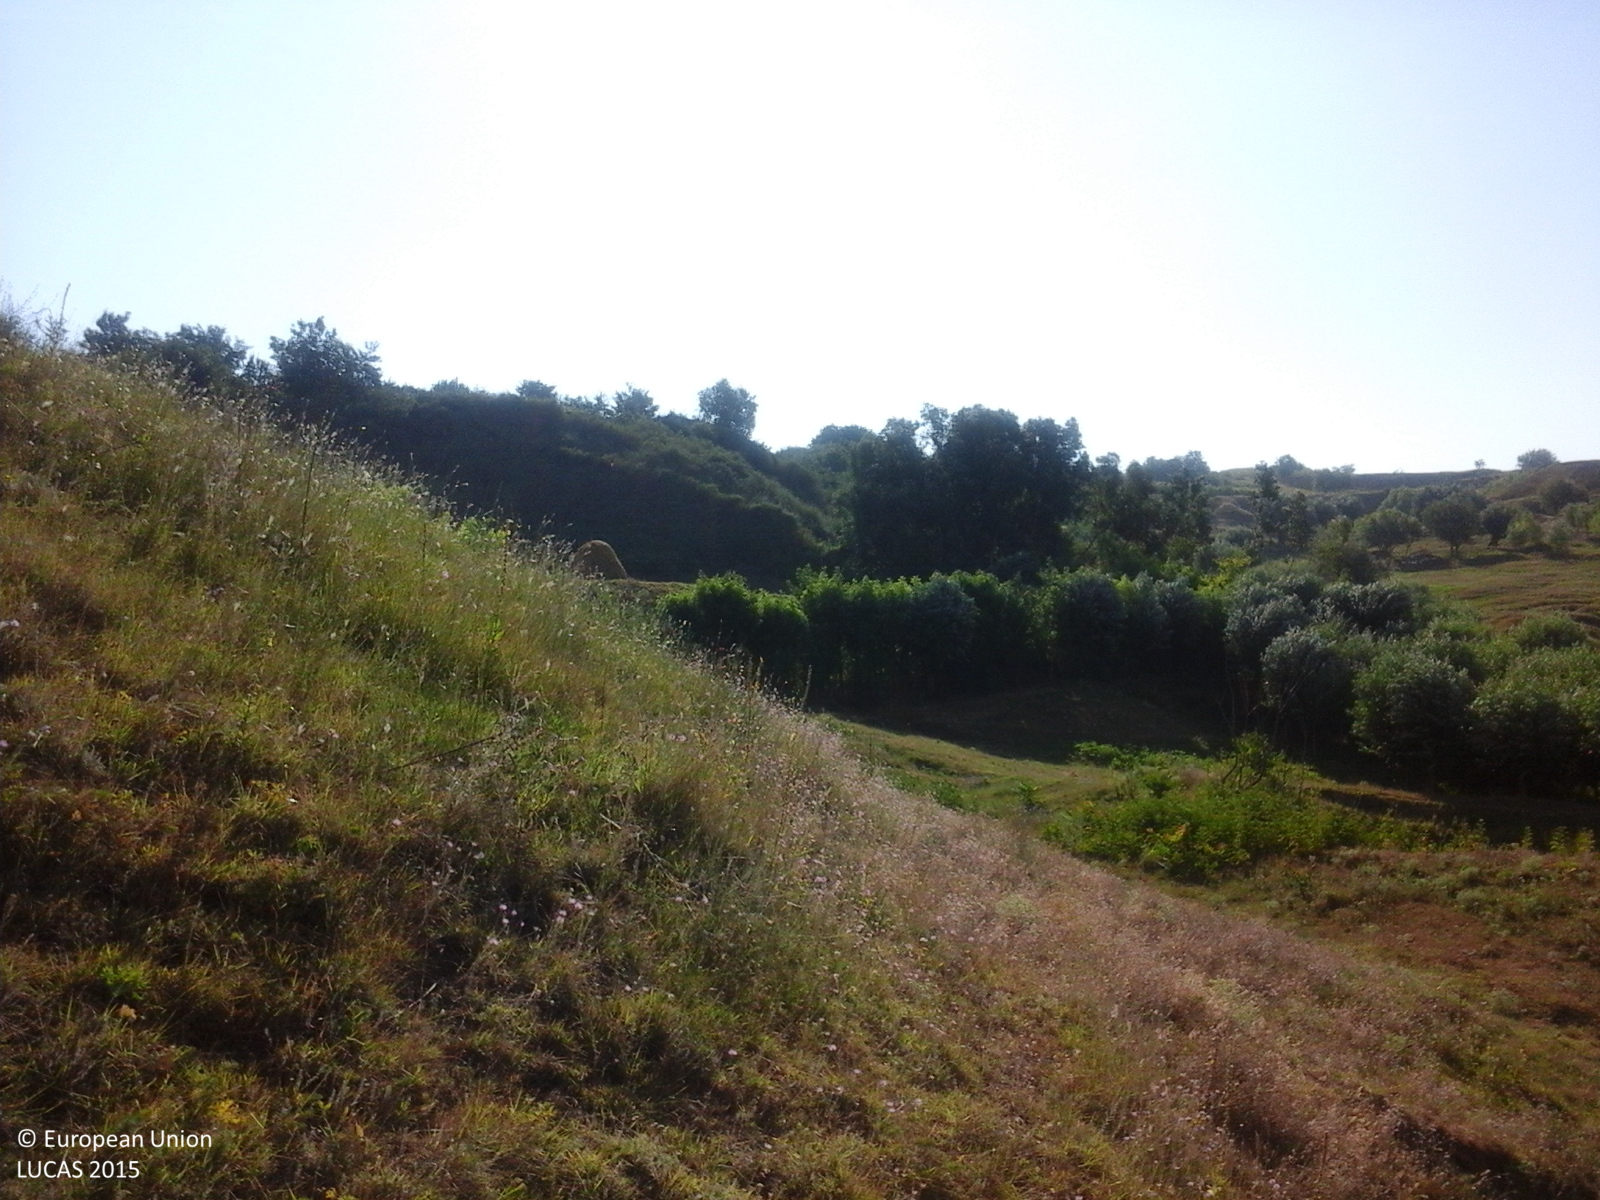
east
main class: Grassland
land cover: Grassland without tree/shrub cover
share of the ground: > 75 %
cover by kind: herbaceous plants 100 %
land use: Agriculture (excluding fallow land and kitchen gardens)
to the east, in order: Grassland without tree/shrub cover; Tracks; Grassland without tree/shrub cover; Abandoned hedges; Grassland without tree/shrub cover; Artificial constructions in urban areas; Broadleaved woodland; Grassland without tree/shrub cover; Artificial constructions in urban areas
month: July
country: RO
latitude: 46.1567
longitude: 27.7657
